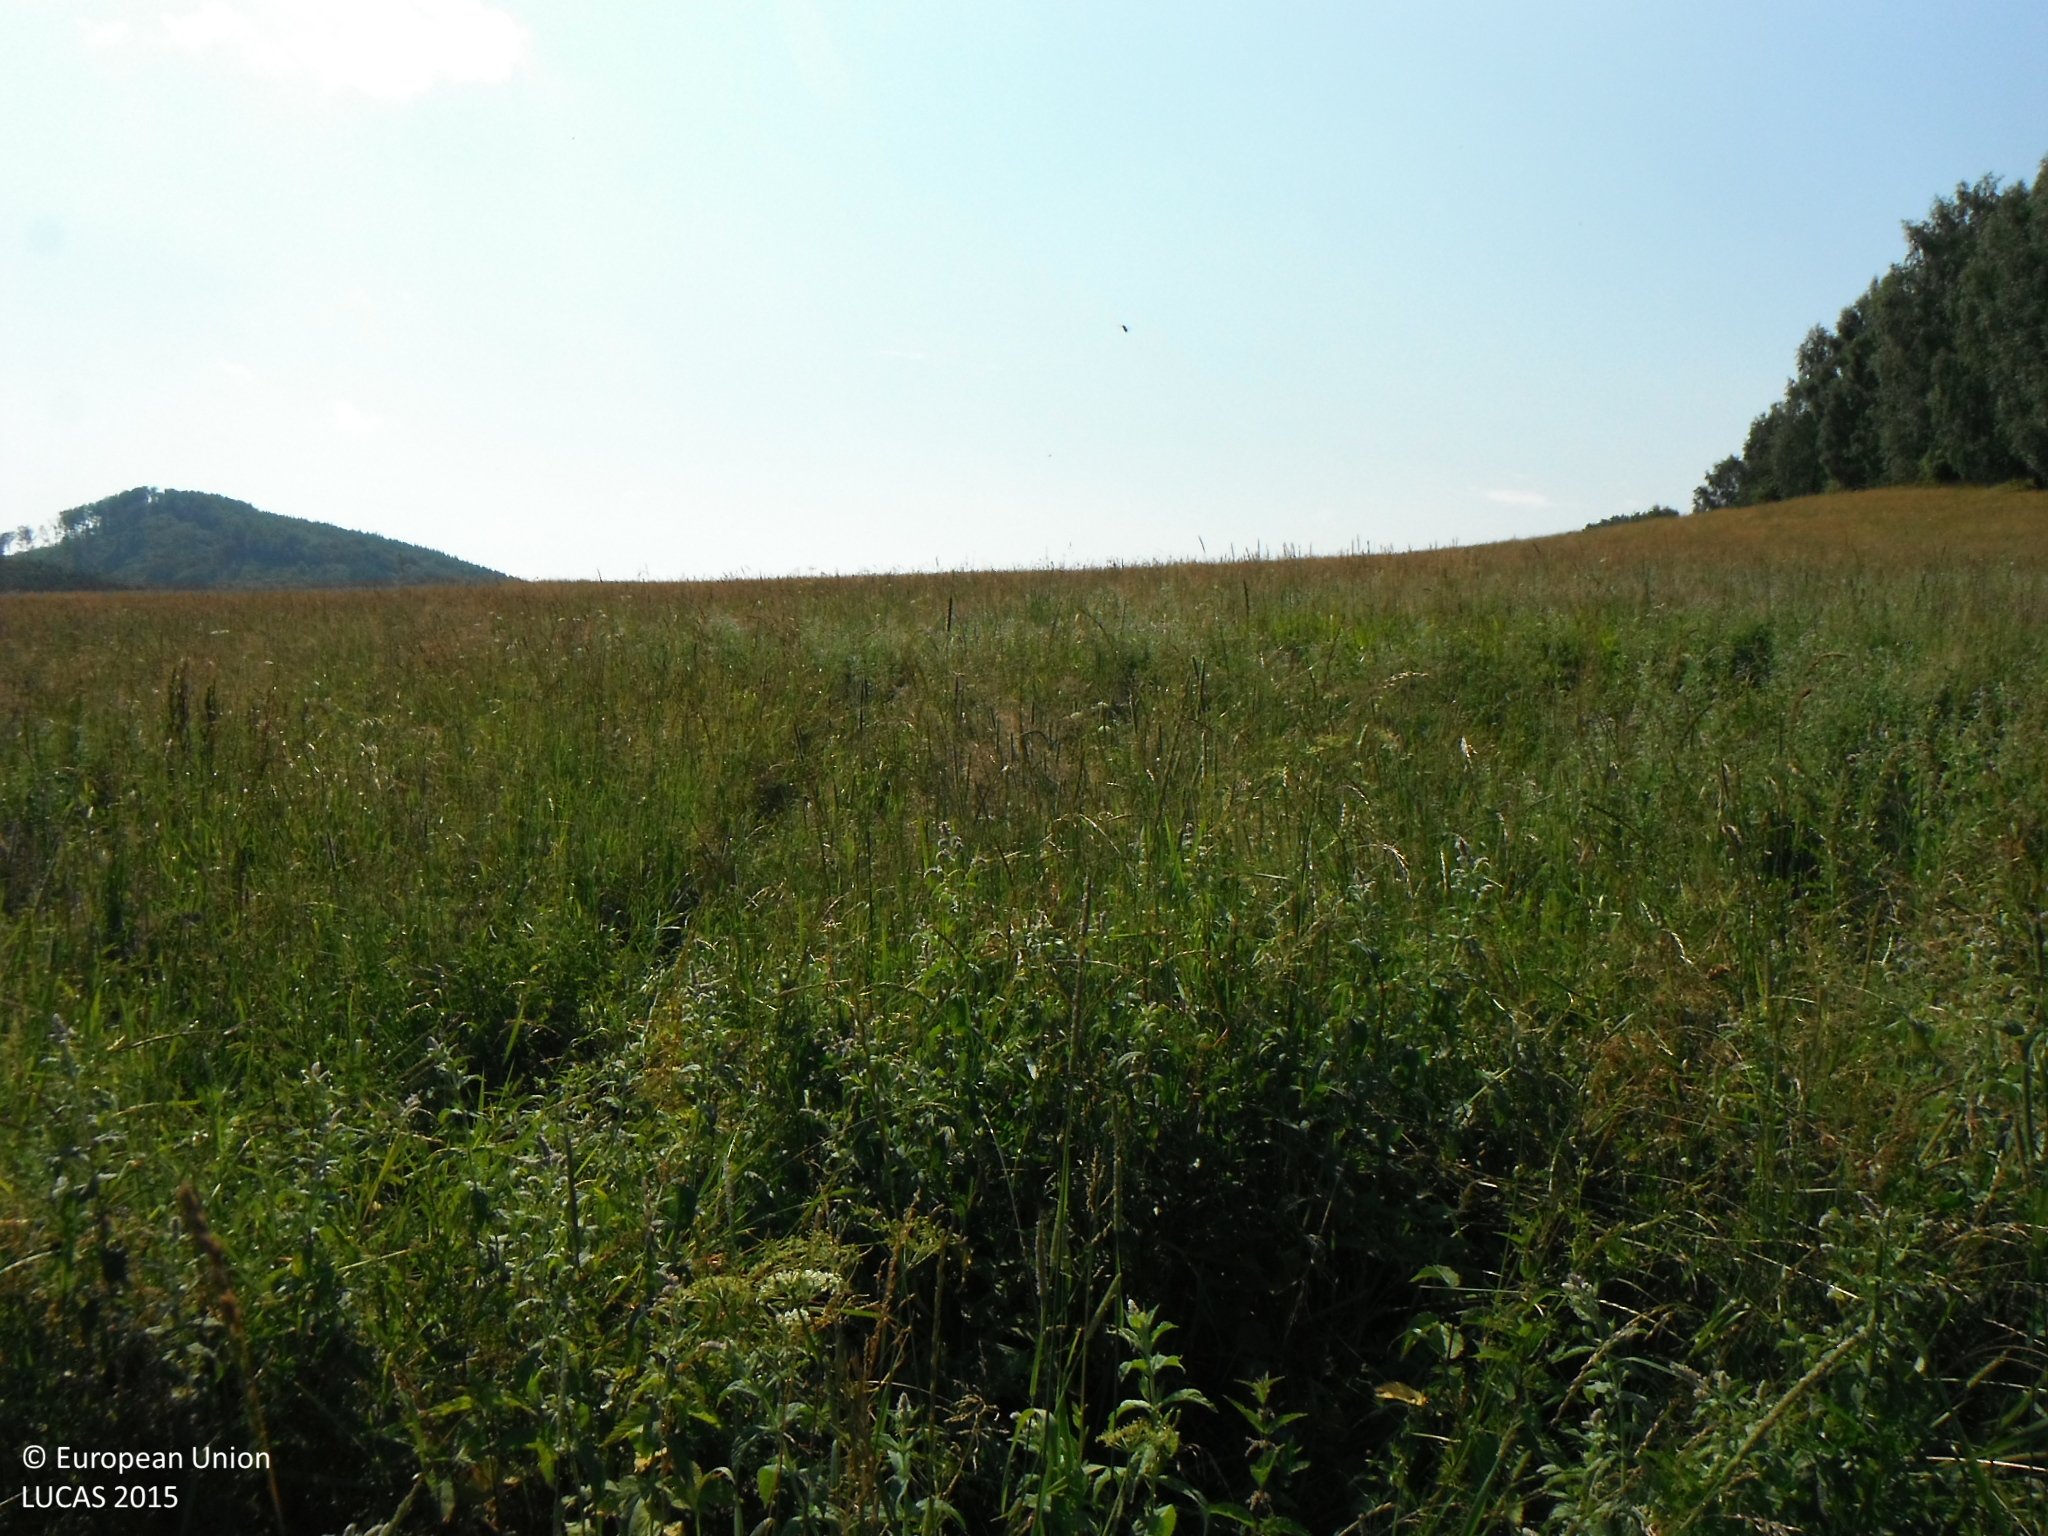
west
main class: Grassland
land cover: Grassland without tree/shrub cover
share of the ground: > 75 %
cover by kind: herbaceous plants 100 %
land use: Agriculture (excluding fallow land and kitchen gardens)
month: July
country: SK
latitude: 49.1953
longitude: 22.0643
